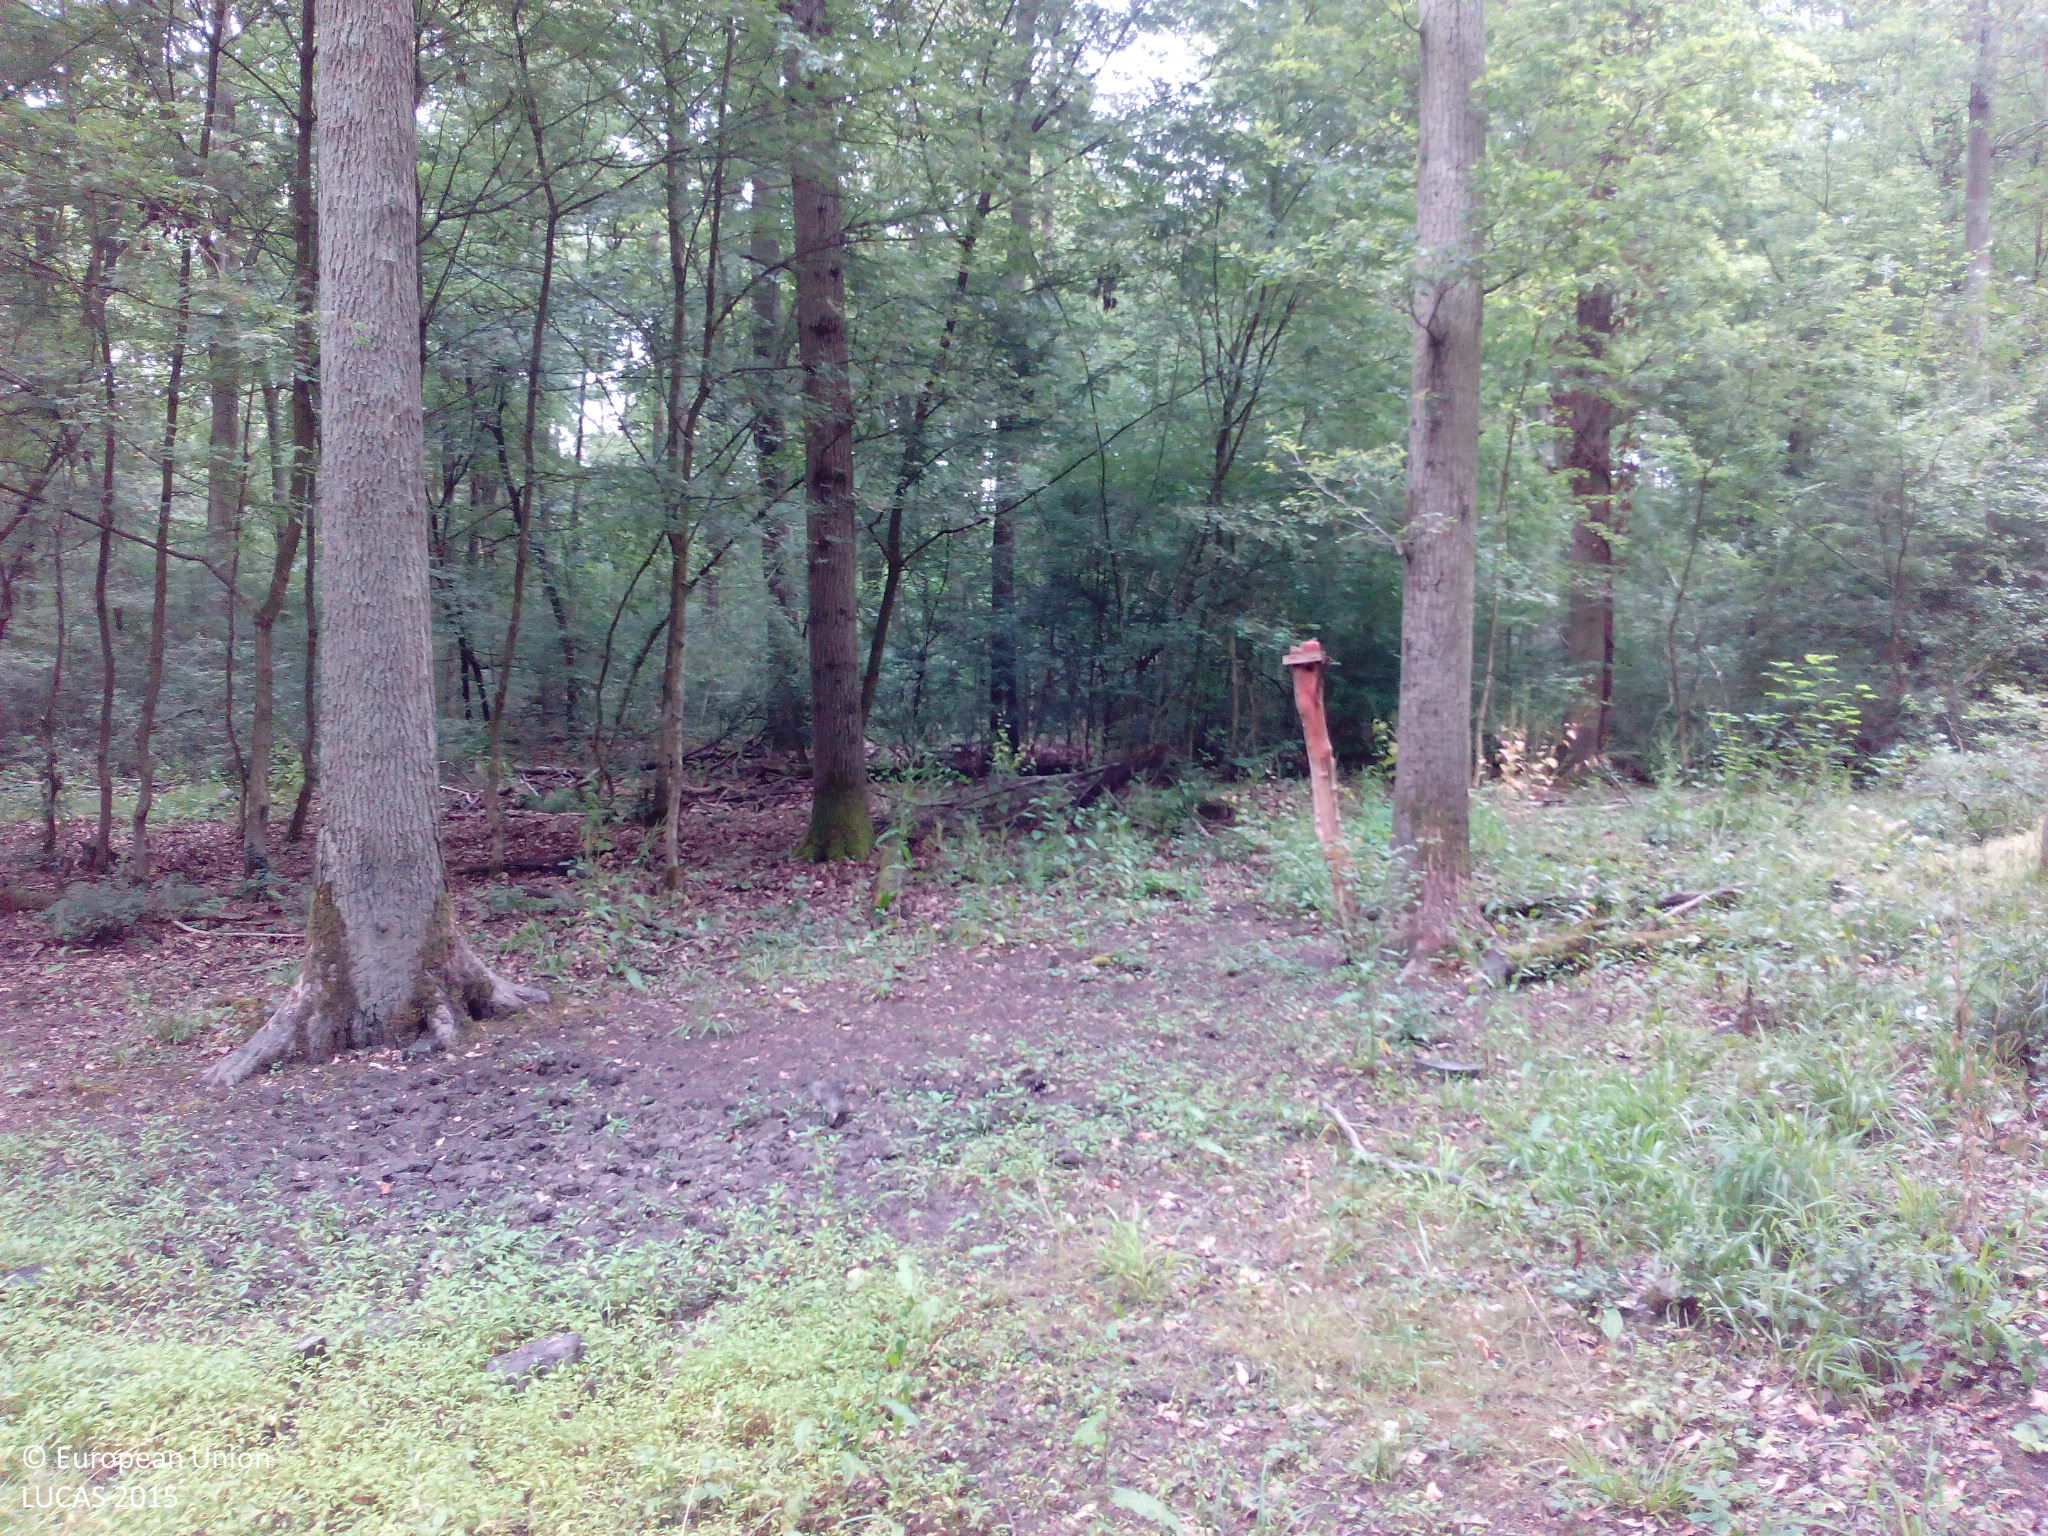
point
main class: Woodland
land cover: Broadleaved woodland
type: mesophytic deciduous forest
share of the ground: 50 - 75 %
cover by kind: broadleaved forest trees 60 %, herbaceous plants 20 %, shrubs 10 %, unconsolidated bare surface 10 %
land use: Forestry
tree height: > 5 m
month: June
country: DE
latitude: 49.7073
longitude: 8.5444
